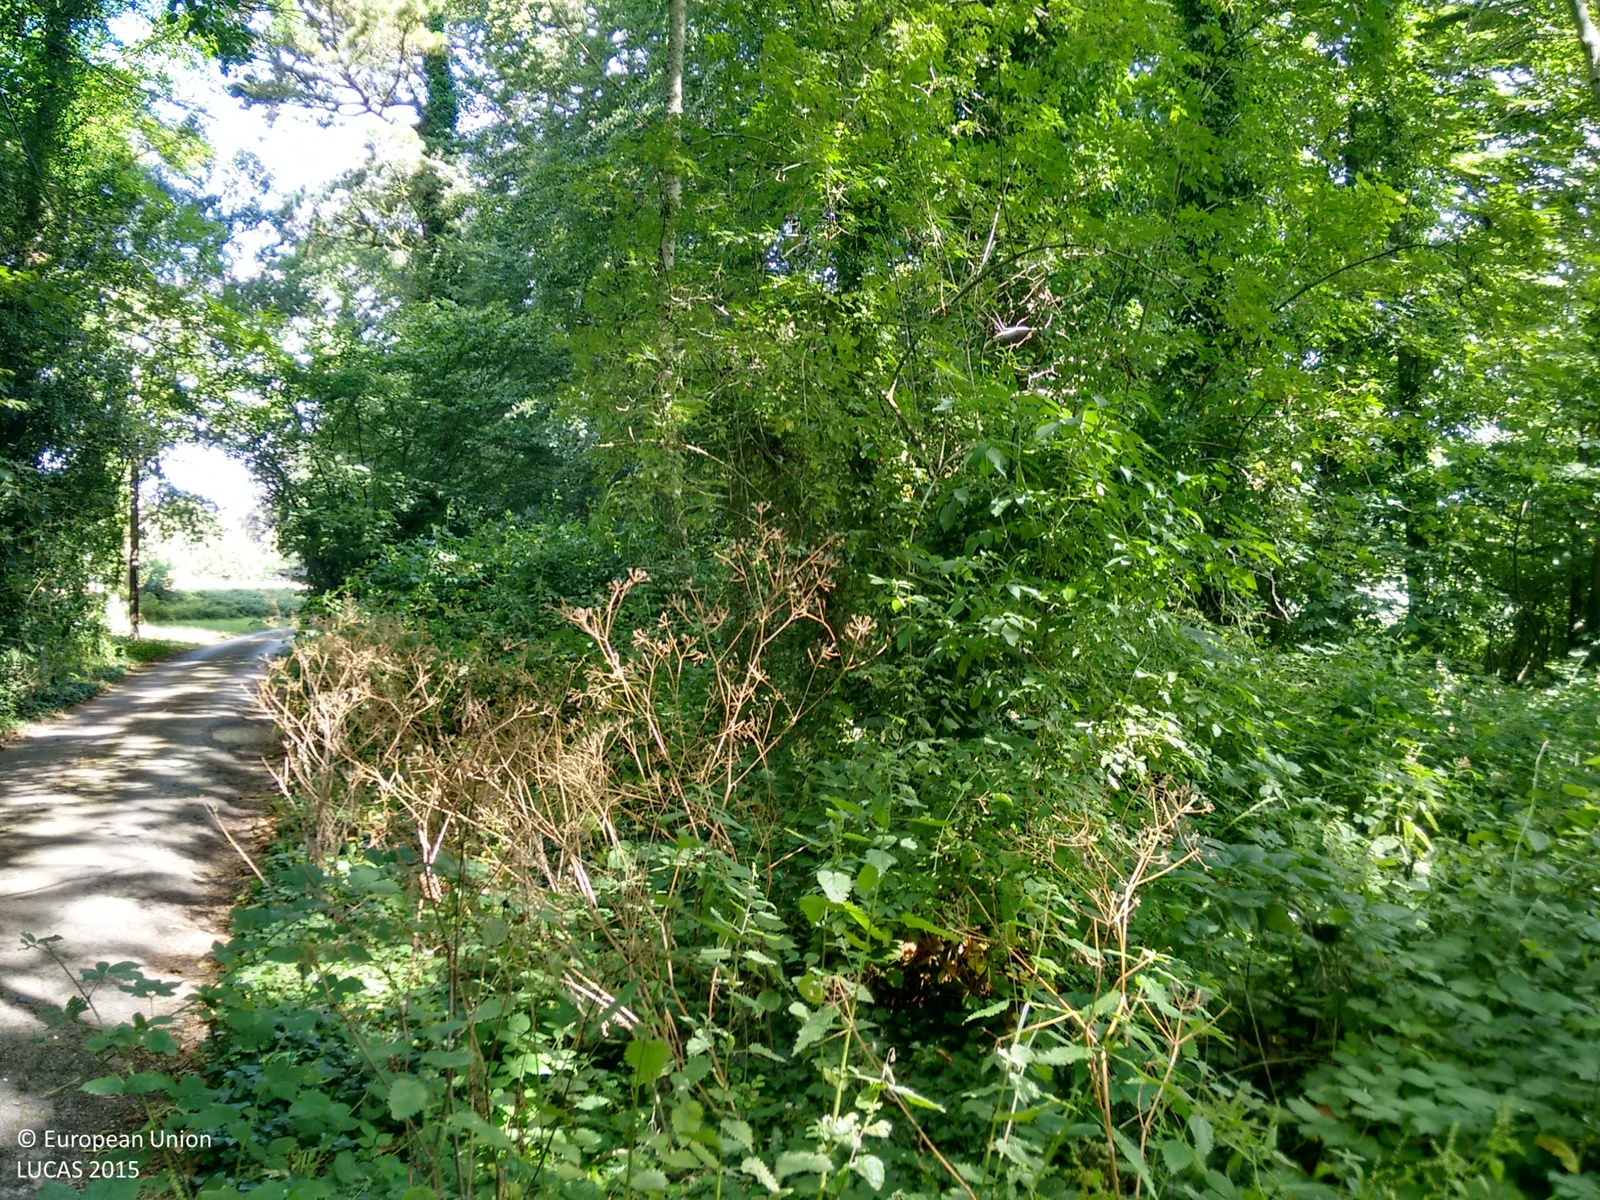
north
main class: Woodland
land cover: Broadleaved woodland
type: mesophytic deciduous forest
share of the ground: > 75 %
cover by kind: broadleaved forest trees 100 %
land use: Semi-natural and natural areas not in use
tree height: > 5 m
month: August
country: GB
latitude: 50.5368
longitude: -3.5592
